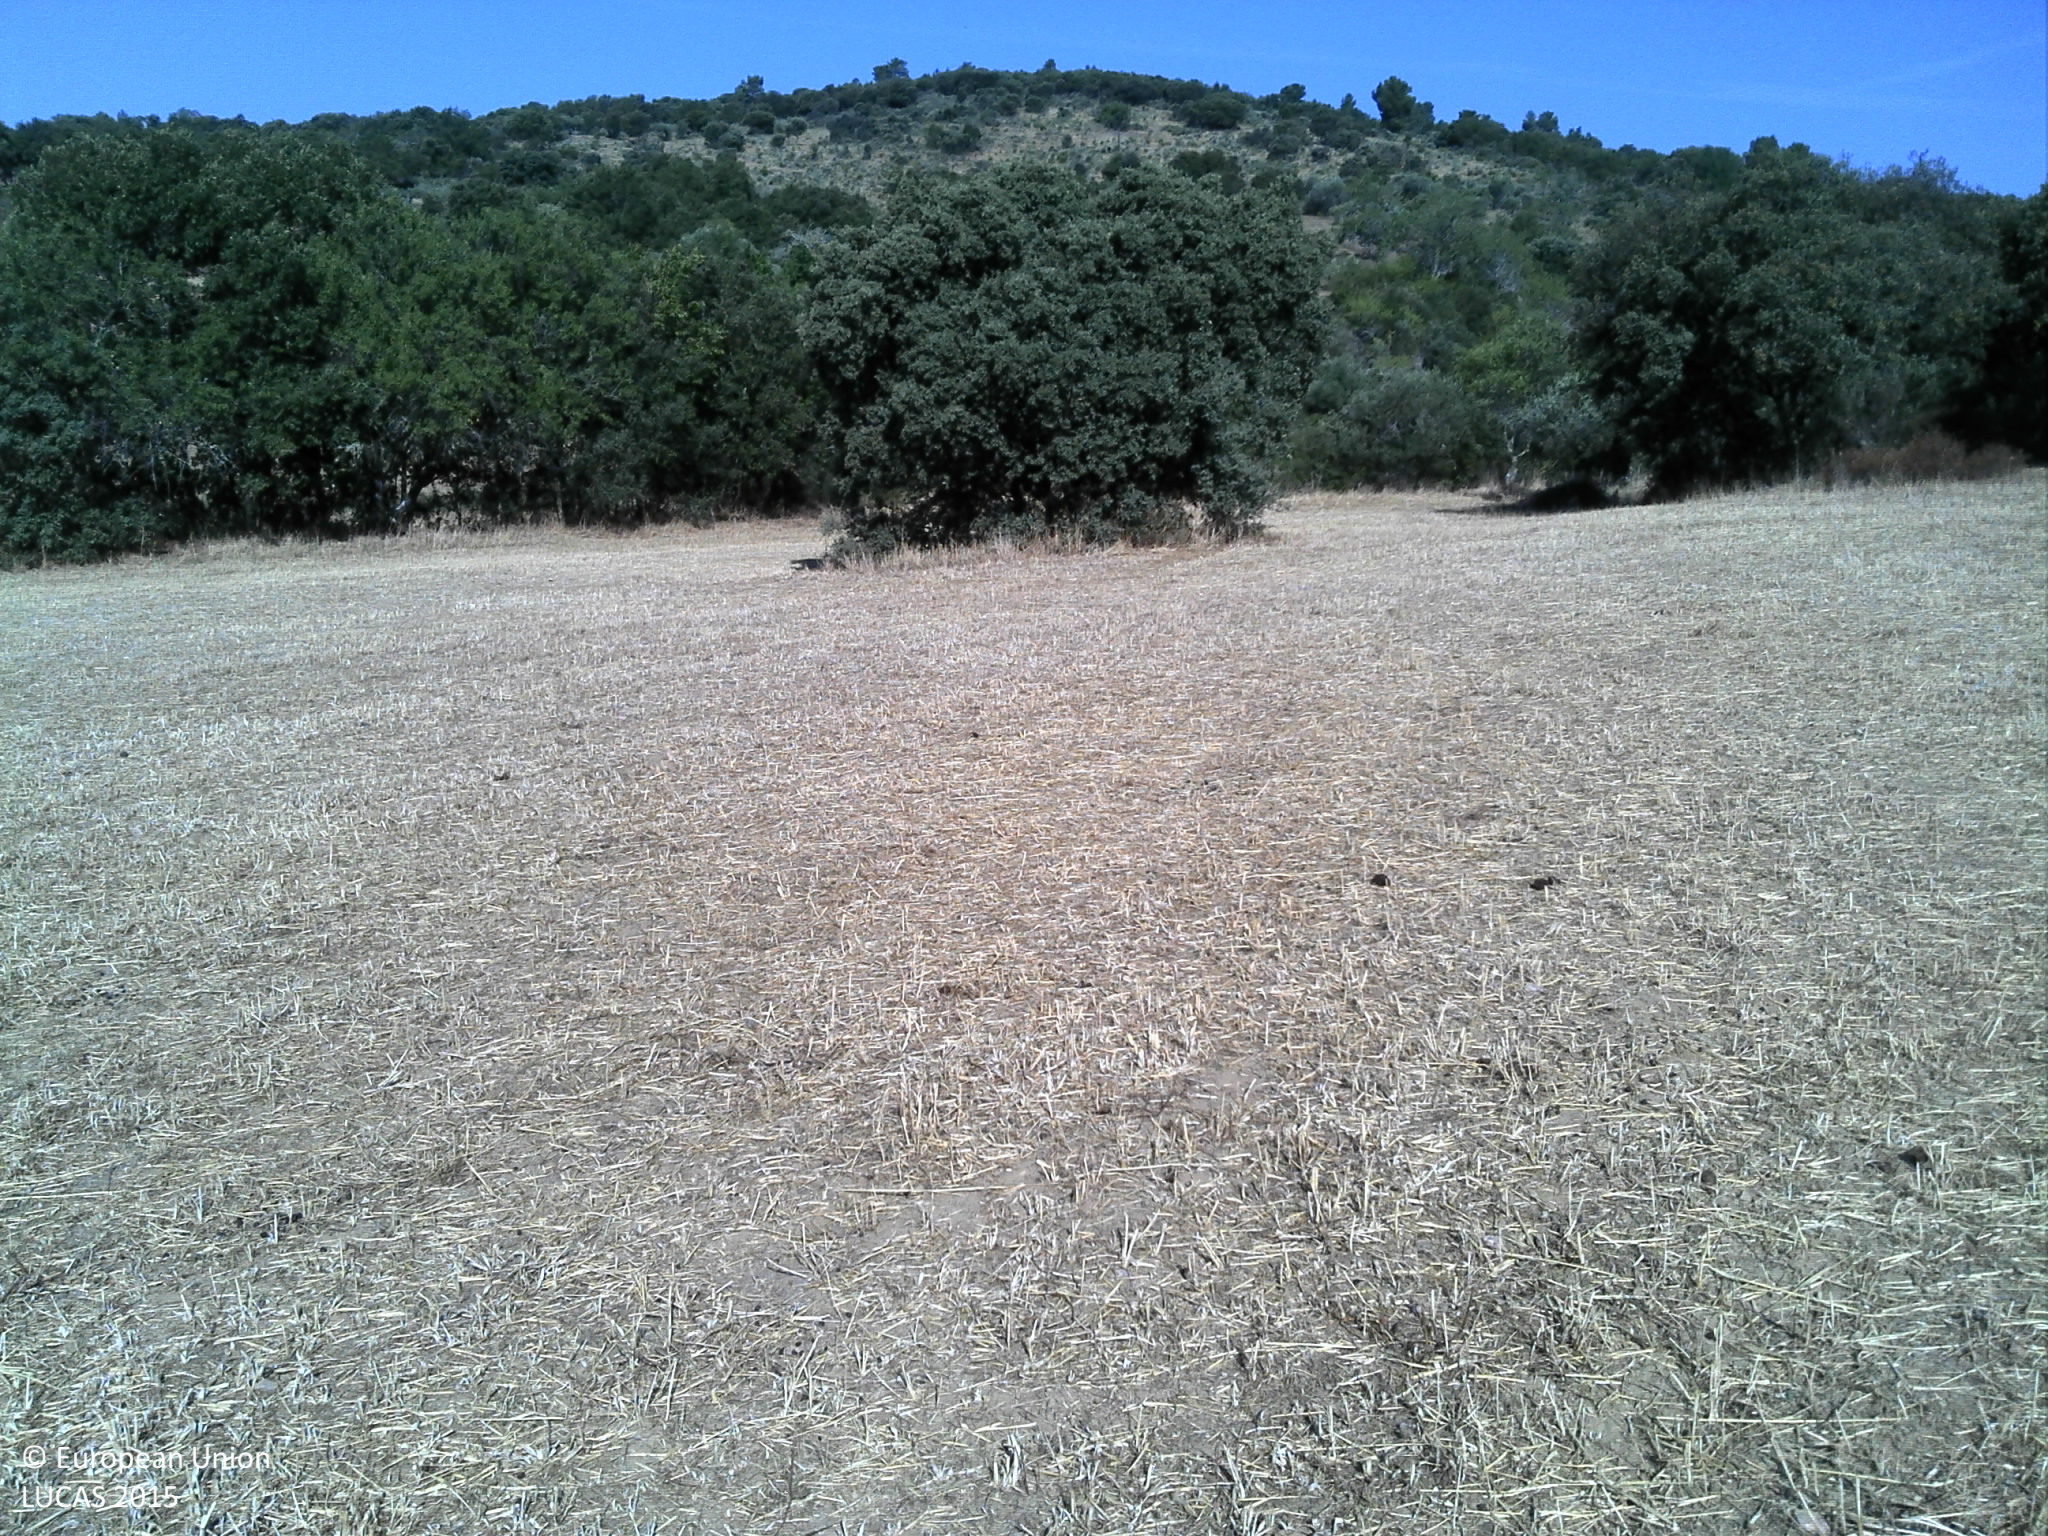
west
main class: Cropland
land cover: Oats
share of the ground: > 75 %
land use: Agriculture (excluding fallow land and kitchen gardens)
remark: Harvested field
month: June
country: PT
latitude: 40.8460
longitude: -6.8363
